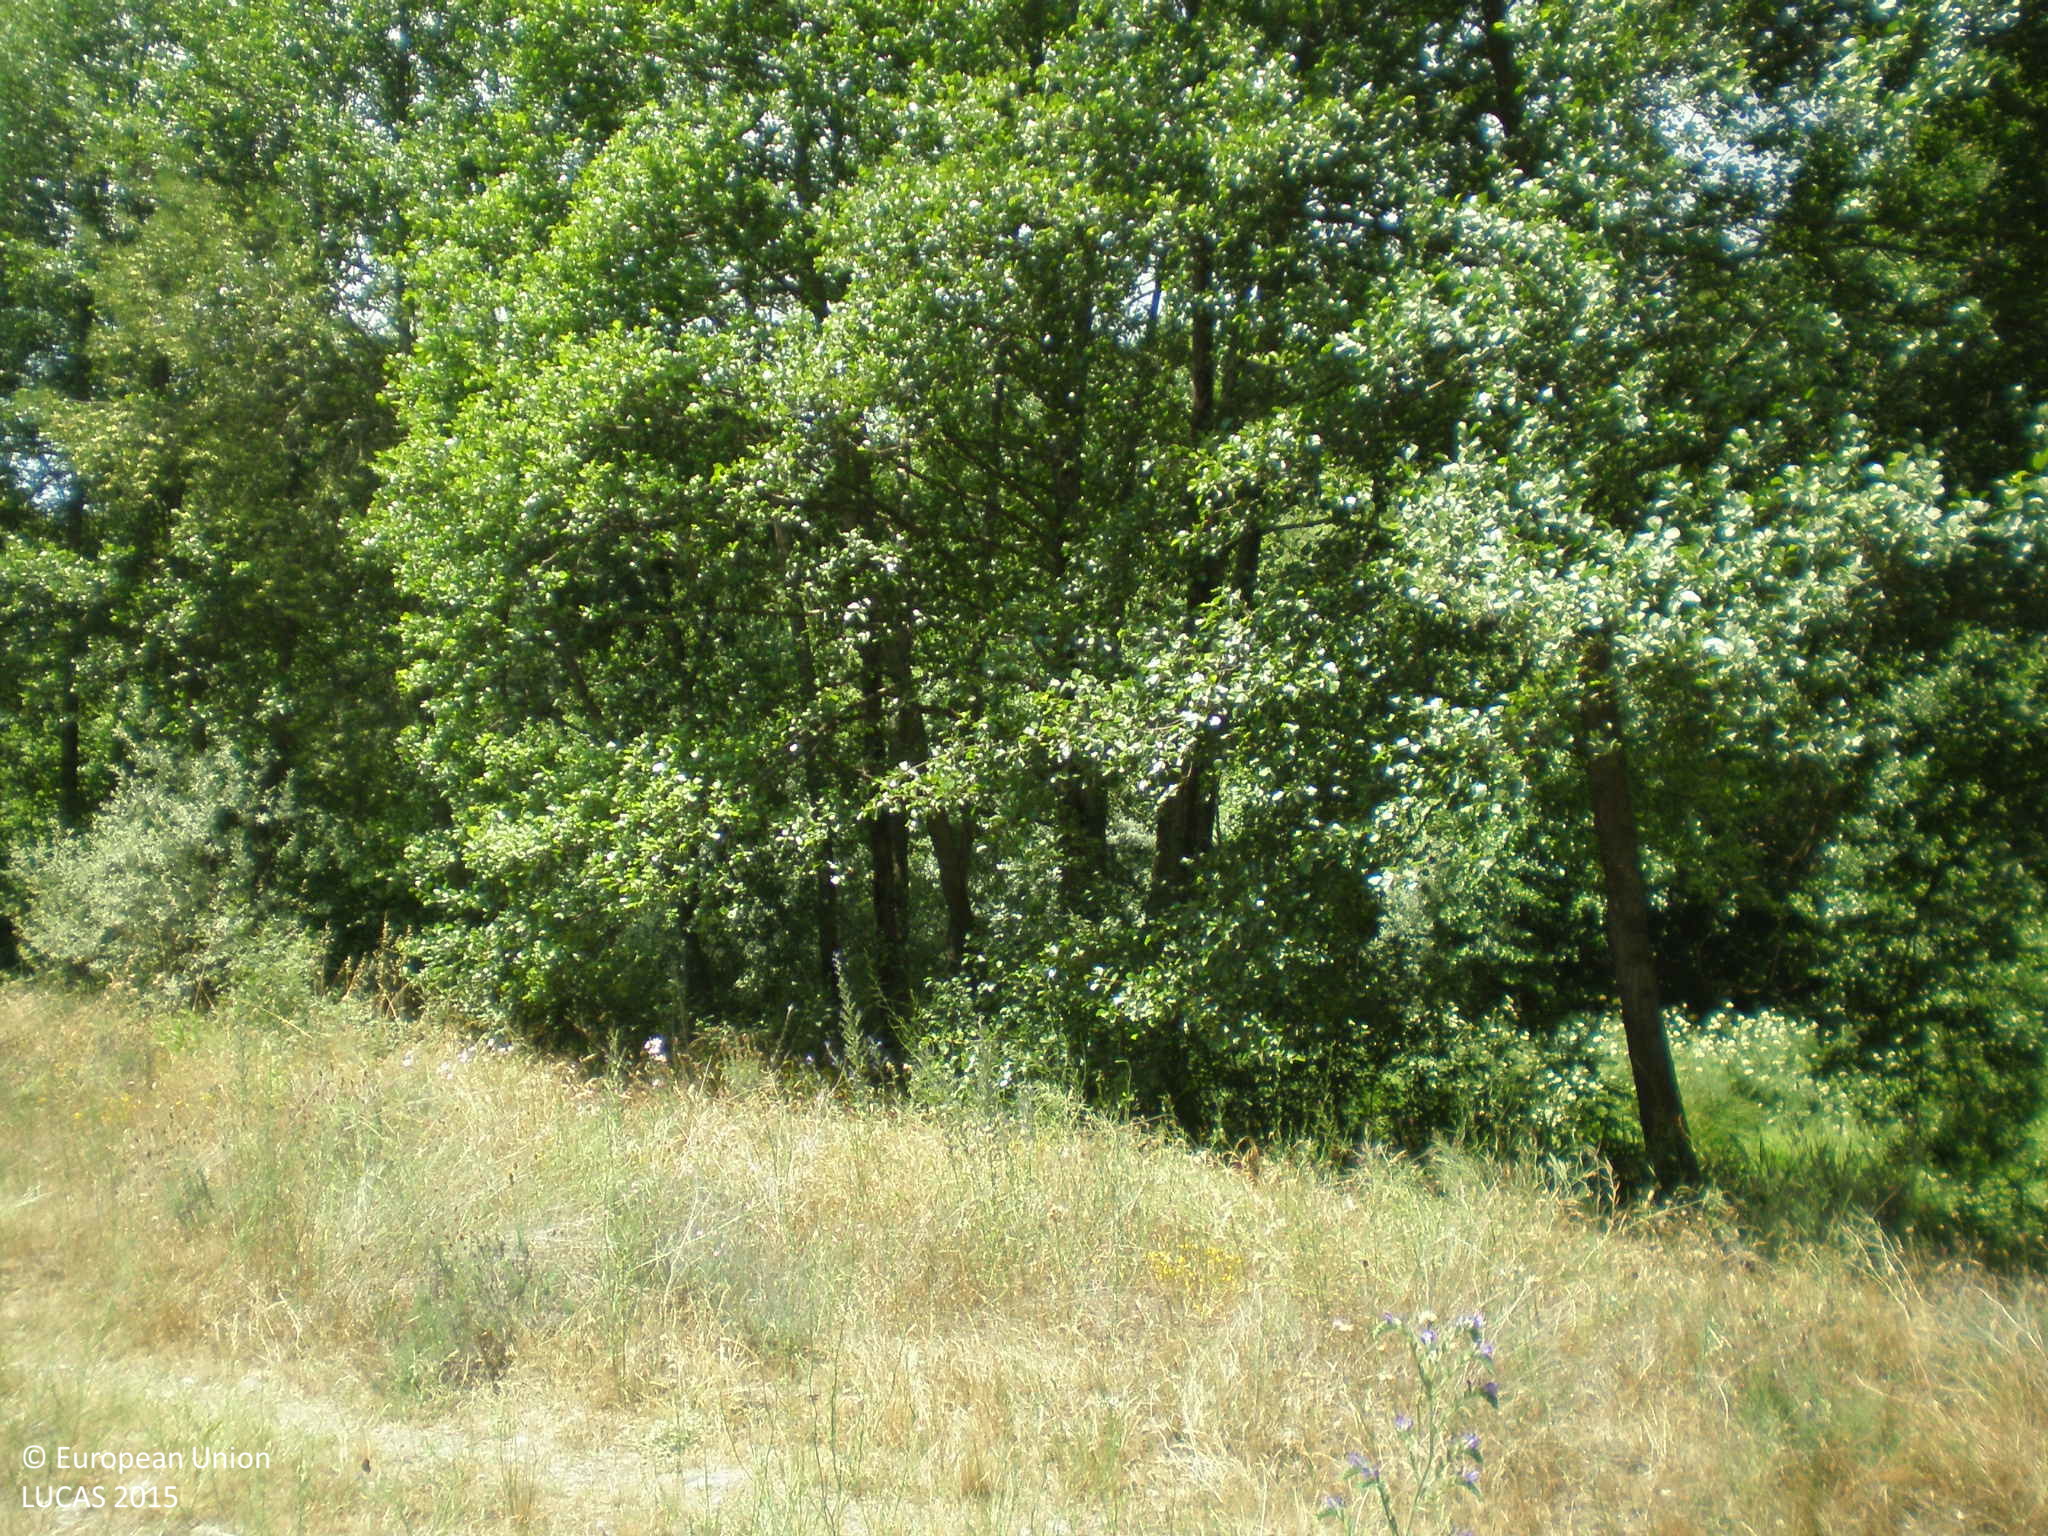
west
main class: Grassland
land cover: Grassland without tree/shrub cover
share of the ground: > 75 %
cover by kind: herbaceous plants 100 %
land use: Semi-natural and natural areas not in use
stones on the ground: < 10 %
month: June
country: ES
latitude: 40.3430
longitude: -5.5465
